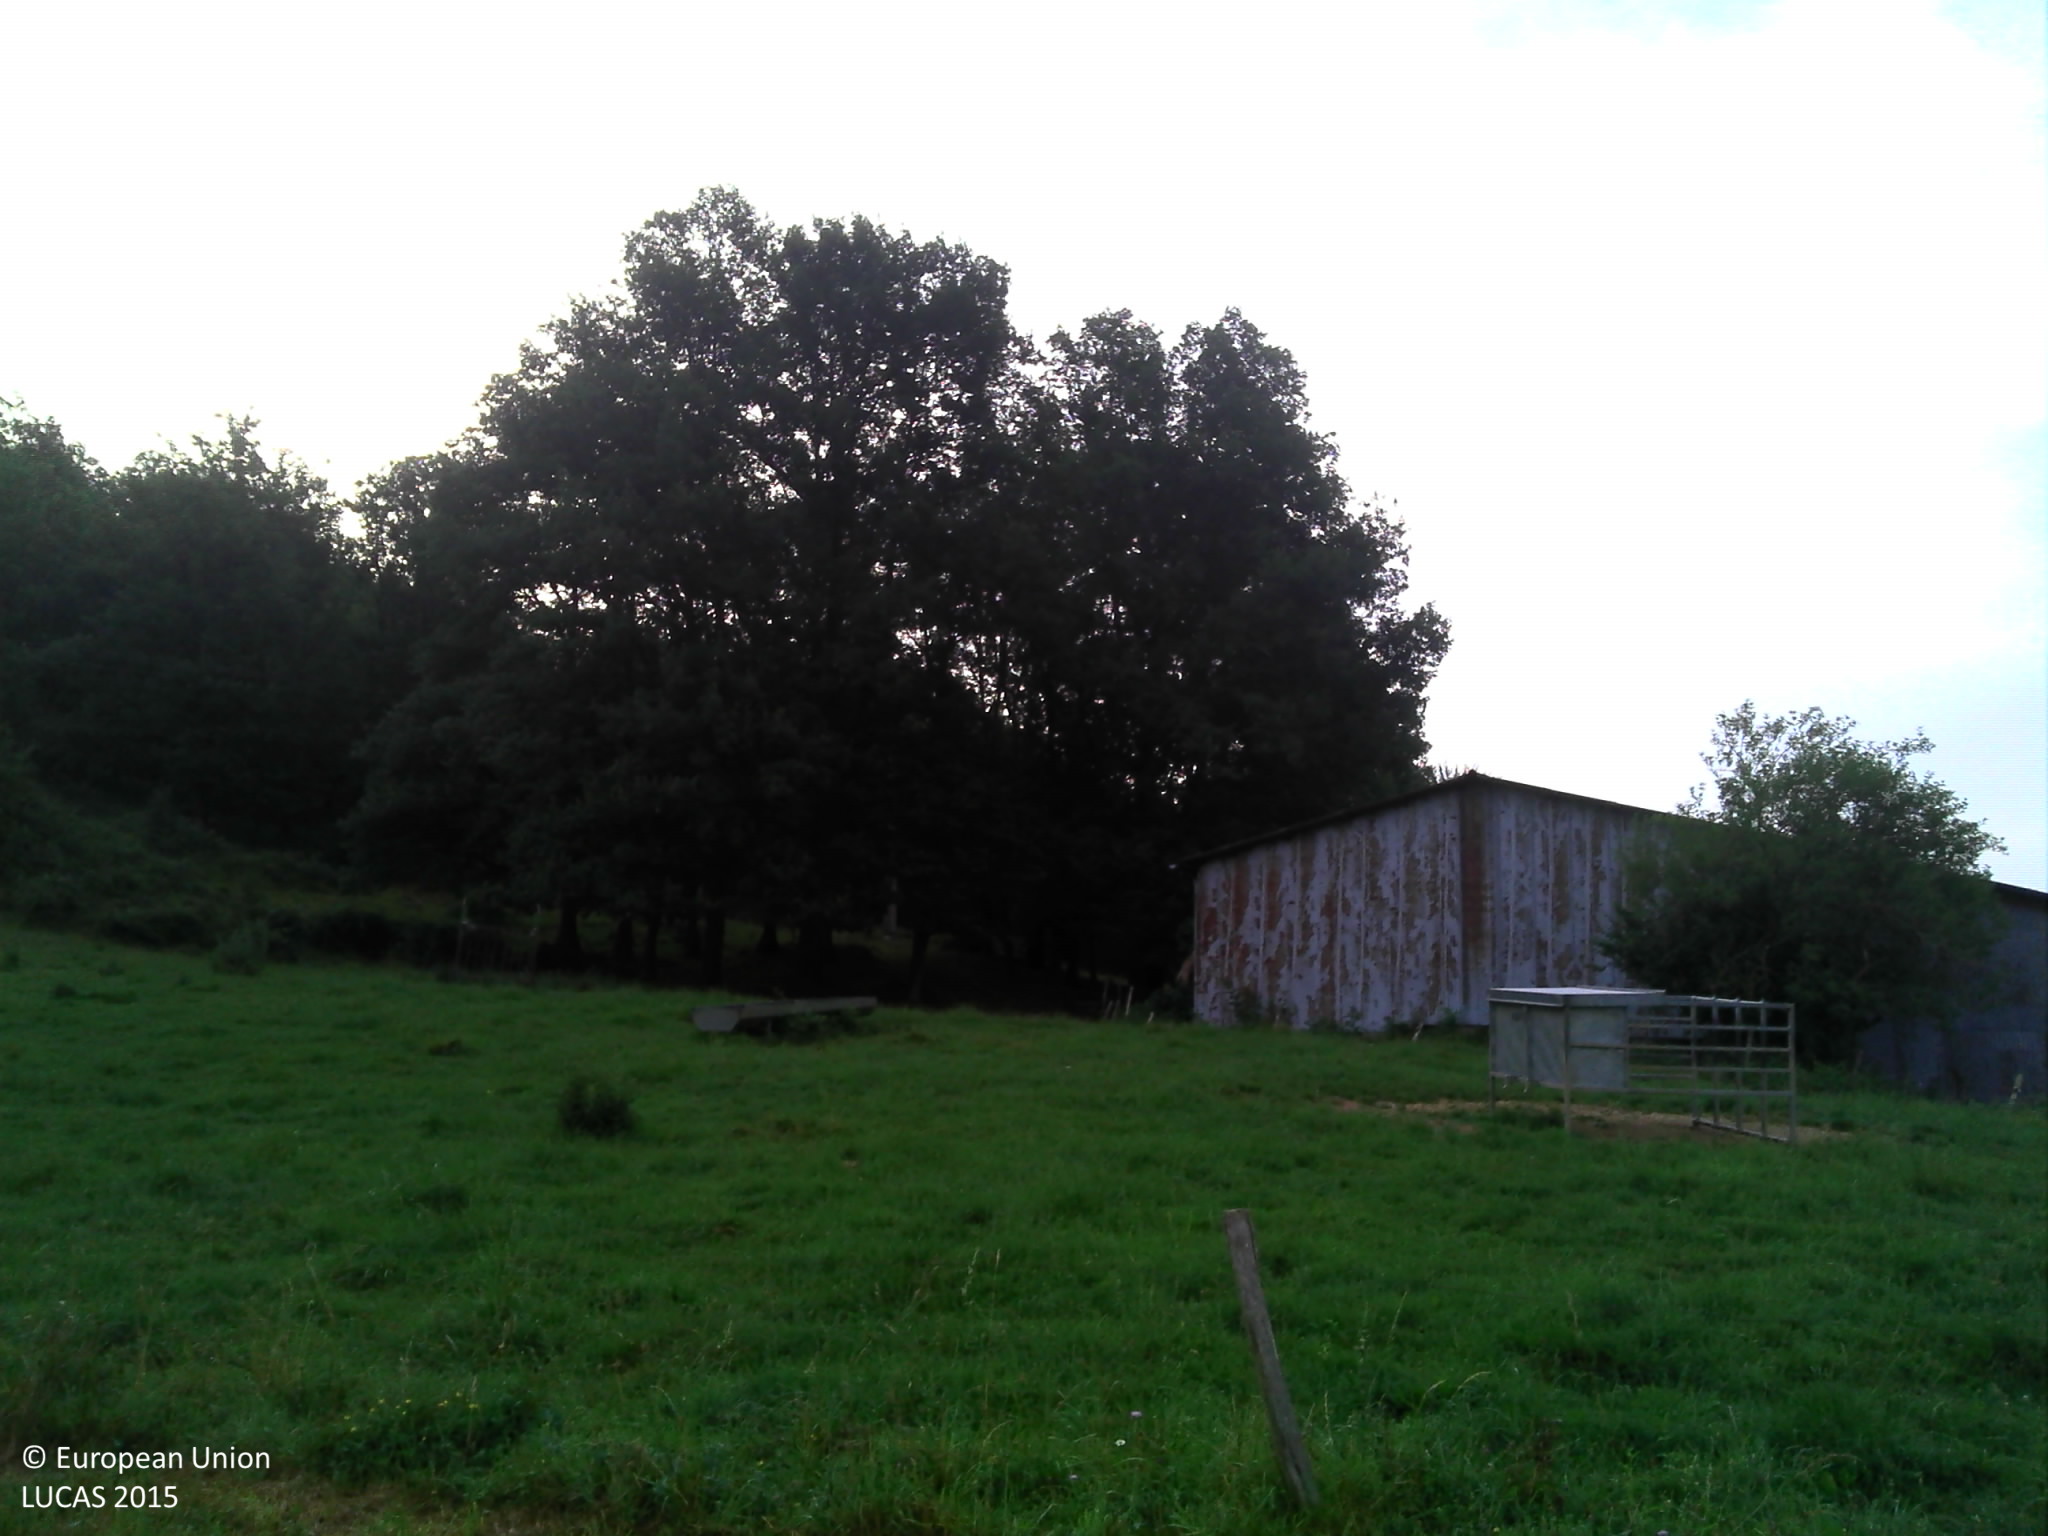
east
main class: Cropland
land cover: Temporary grasslands
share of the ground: > 75 %
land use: Agriculture (excluding fallow land and kitchen gardens)
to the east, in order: Temporary grasslands; Fences; Grassland without tree/shrub cover; Artificial constructions in urban areas; Grassland without tree/shrub cover; Broadleaved woodland; Tracks; Broadleaved woodland
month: July
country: FR
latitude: 43.0581
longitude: 1.4971
